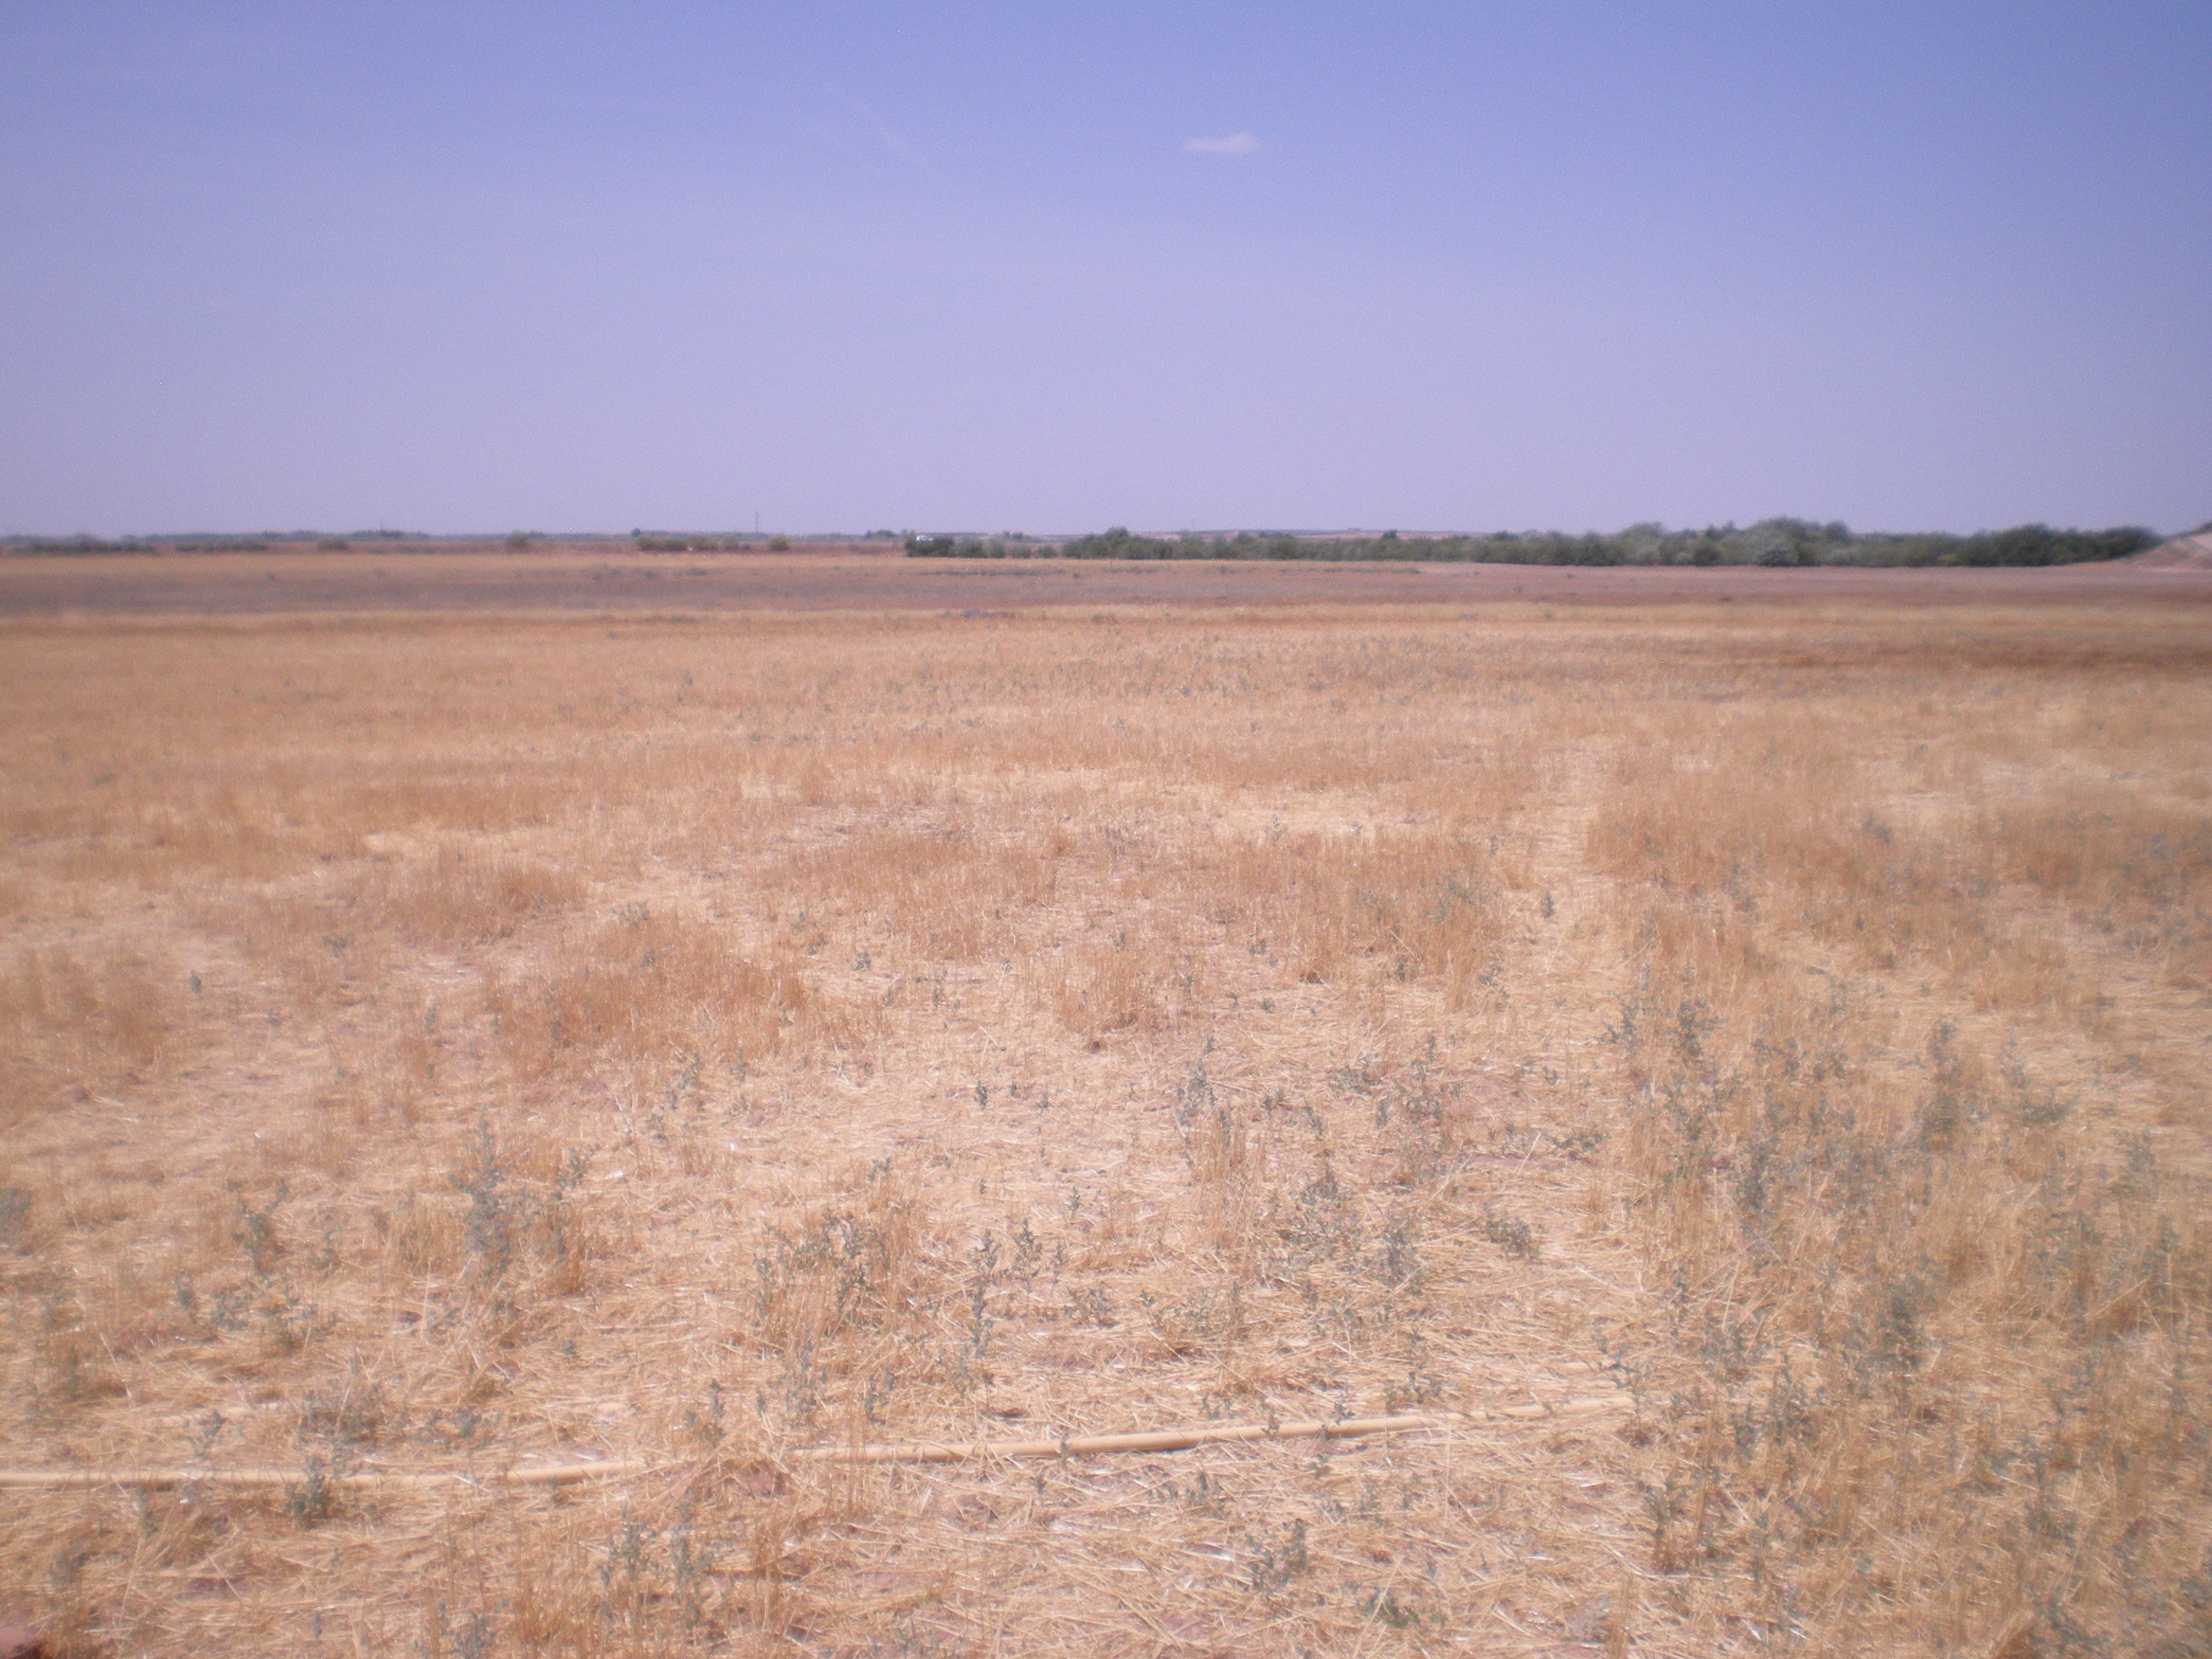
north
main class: Cropland
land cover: Barley
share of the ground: < 10 %
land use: Agriculture (excluding fallow land and kitchen gardens)
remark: Harvested field
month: July
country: ES
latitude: 39.3953
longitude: -3.2908
